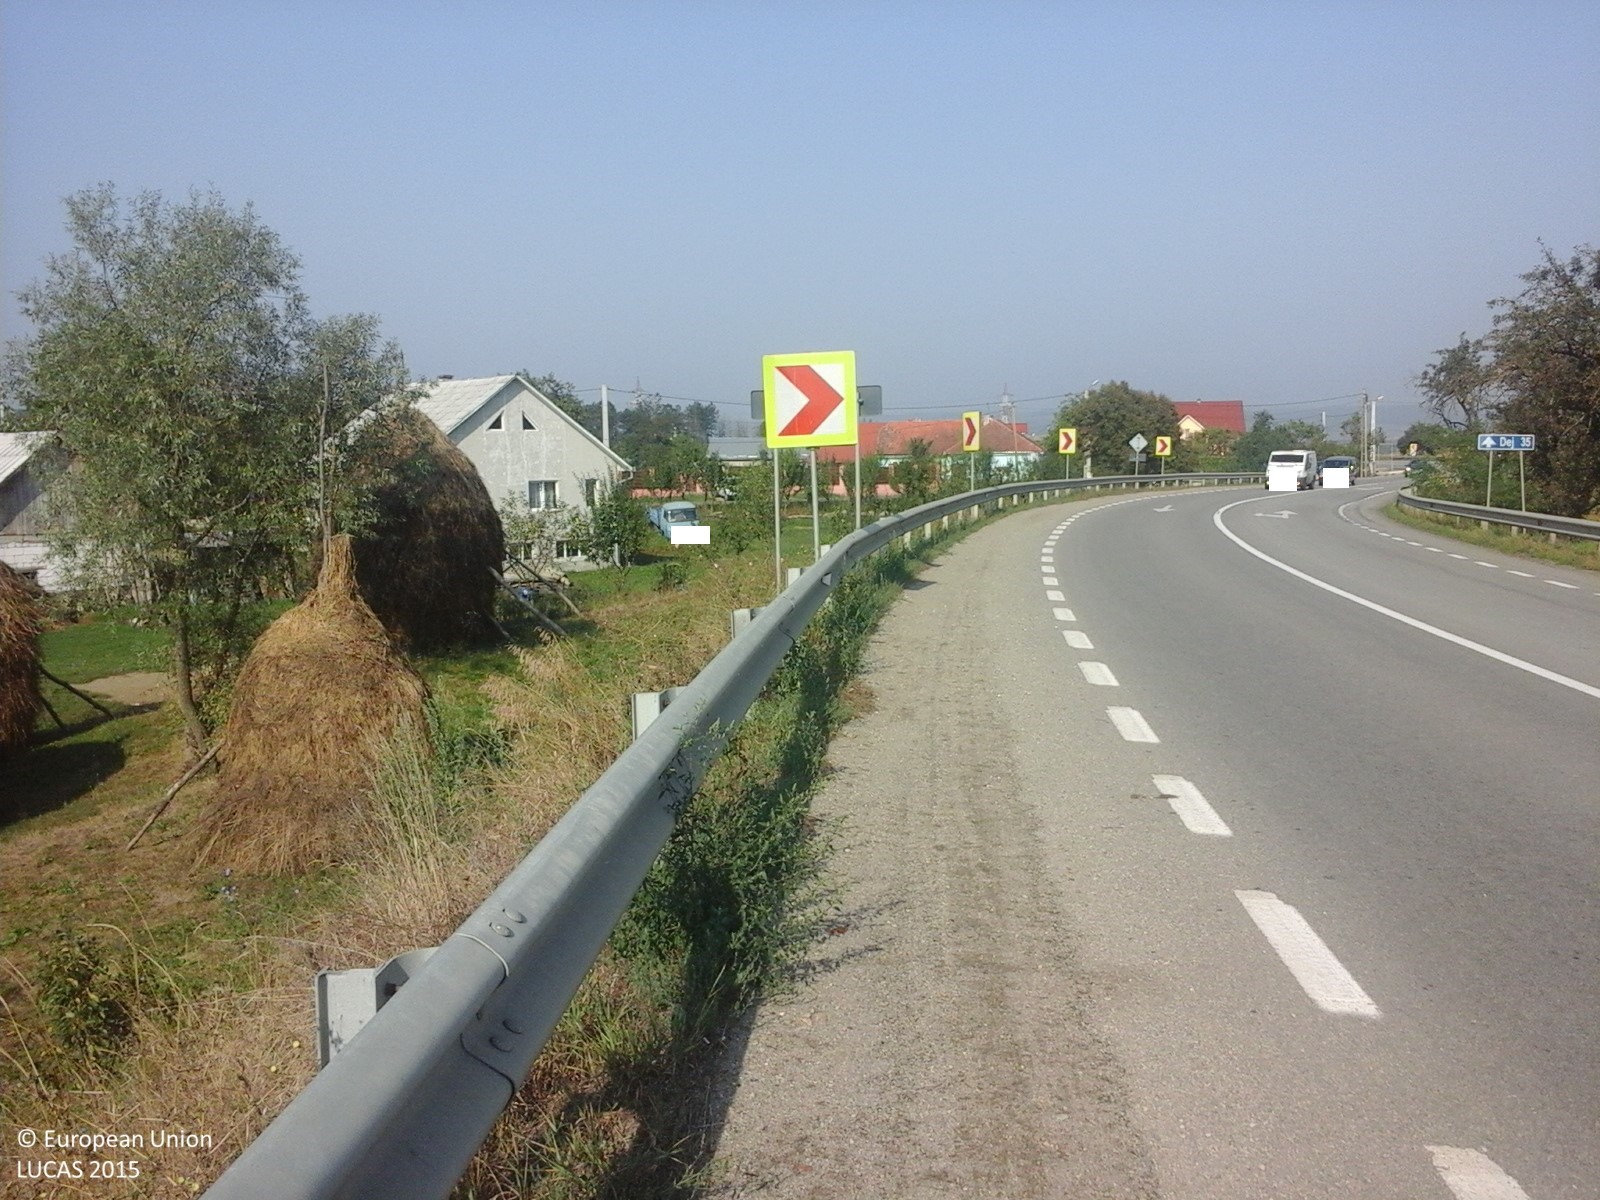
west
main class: Grassland
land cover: Grassland without tree/shrub cover
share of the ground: > 75 %
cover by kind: herbaceous plants 100 %
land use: Agriculture (excluding fallow land and kitchen gardens)
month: September
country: RO
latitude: 47.1793
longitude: 24.2716
